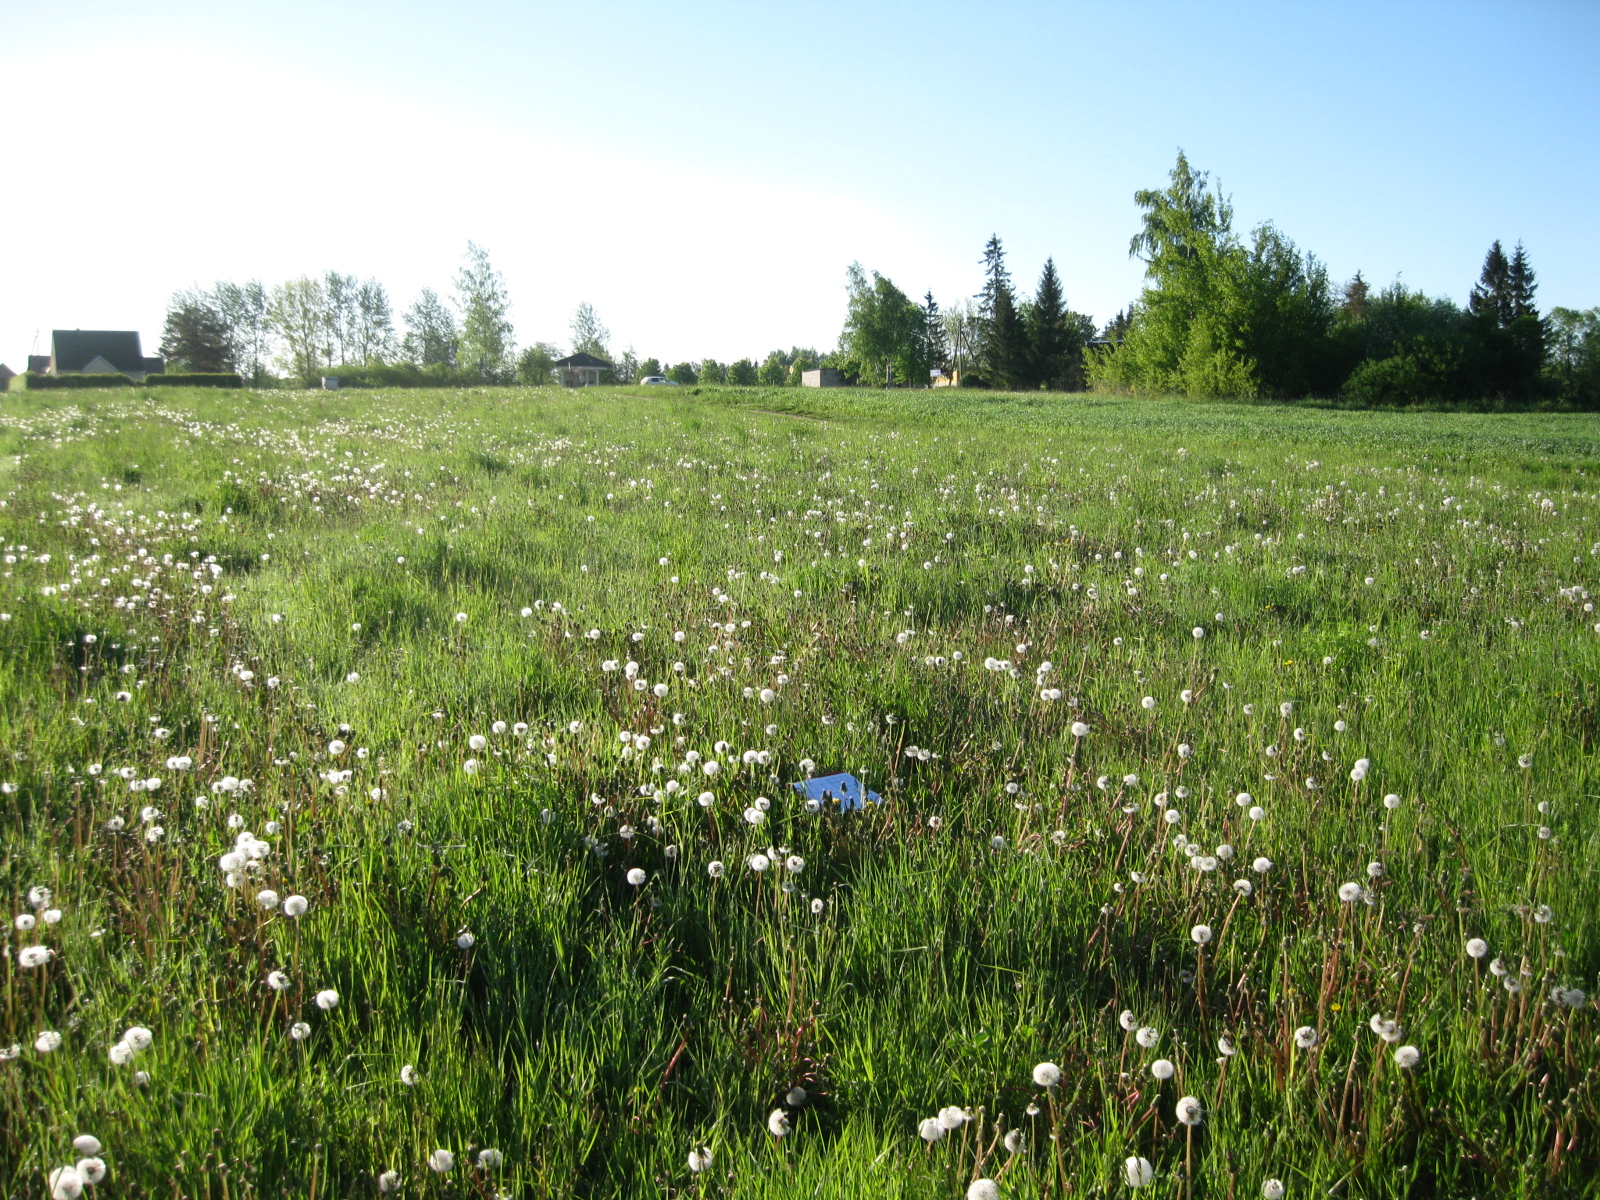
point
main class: Grassland
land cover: Grassland without tree/shrub cover
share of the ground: > 75 %
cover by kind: herbaceous plants 100 %
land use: Agriculture (excluding fallow land and kitchen gardens)
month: May
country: LT
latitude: 56.2191
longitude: 24.0033
